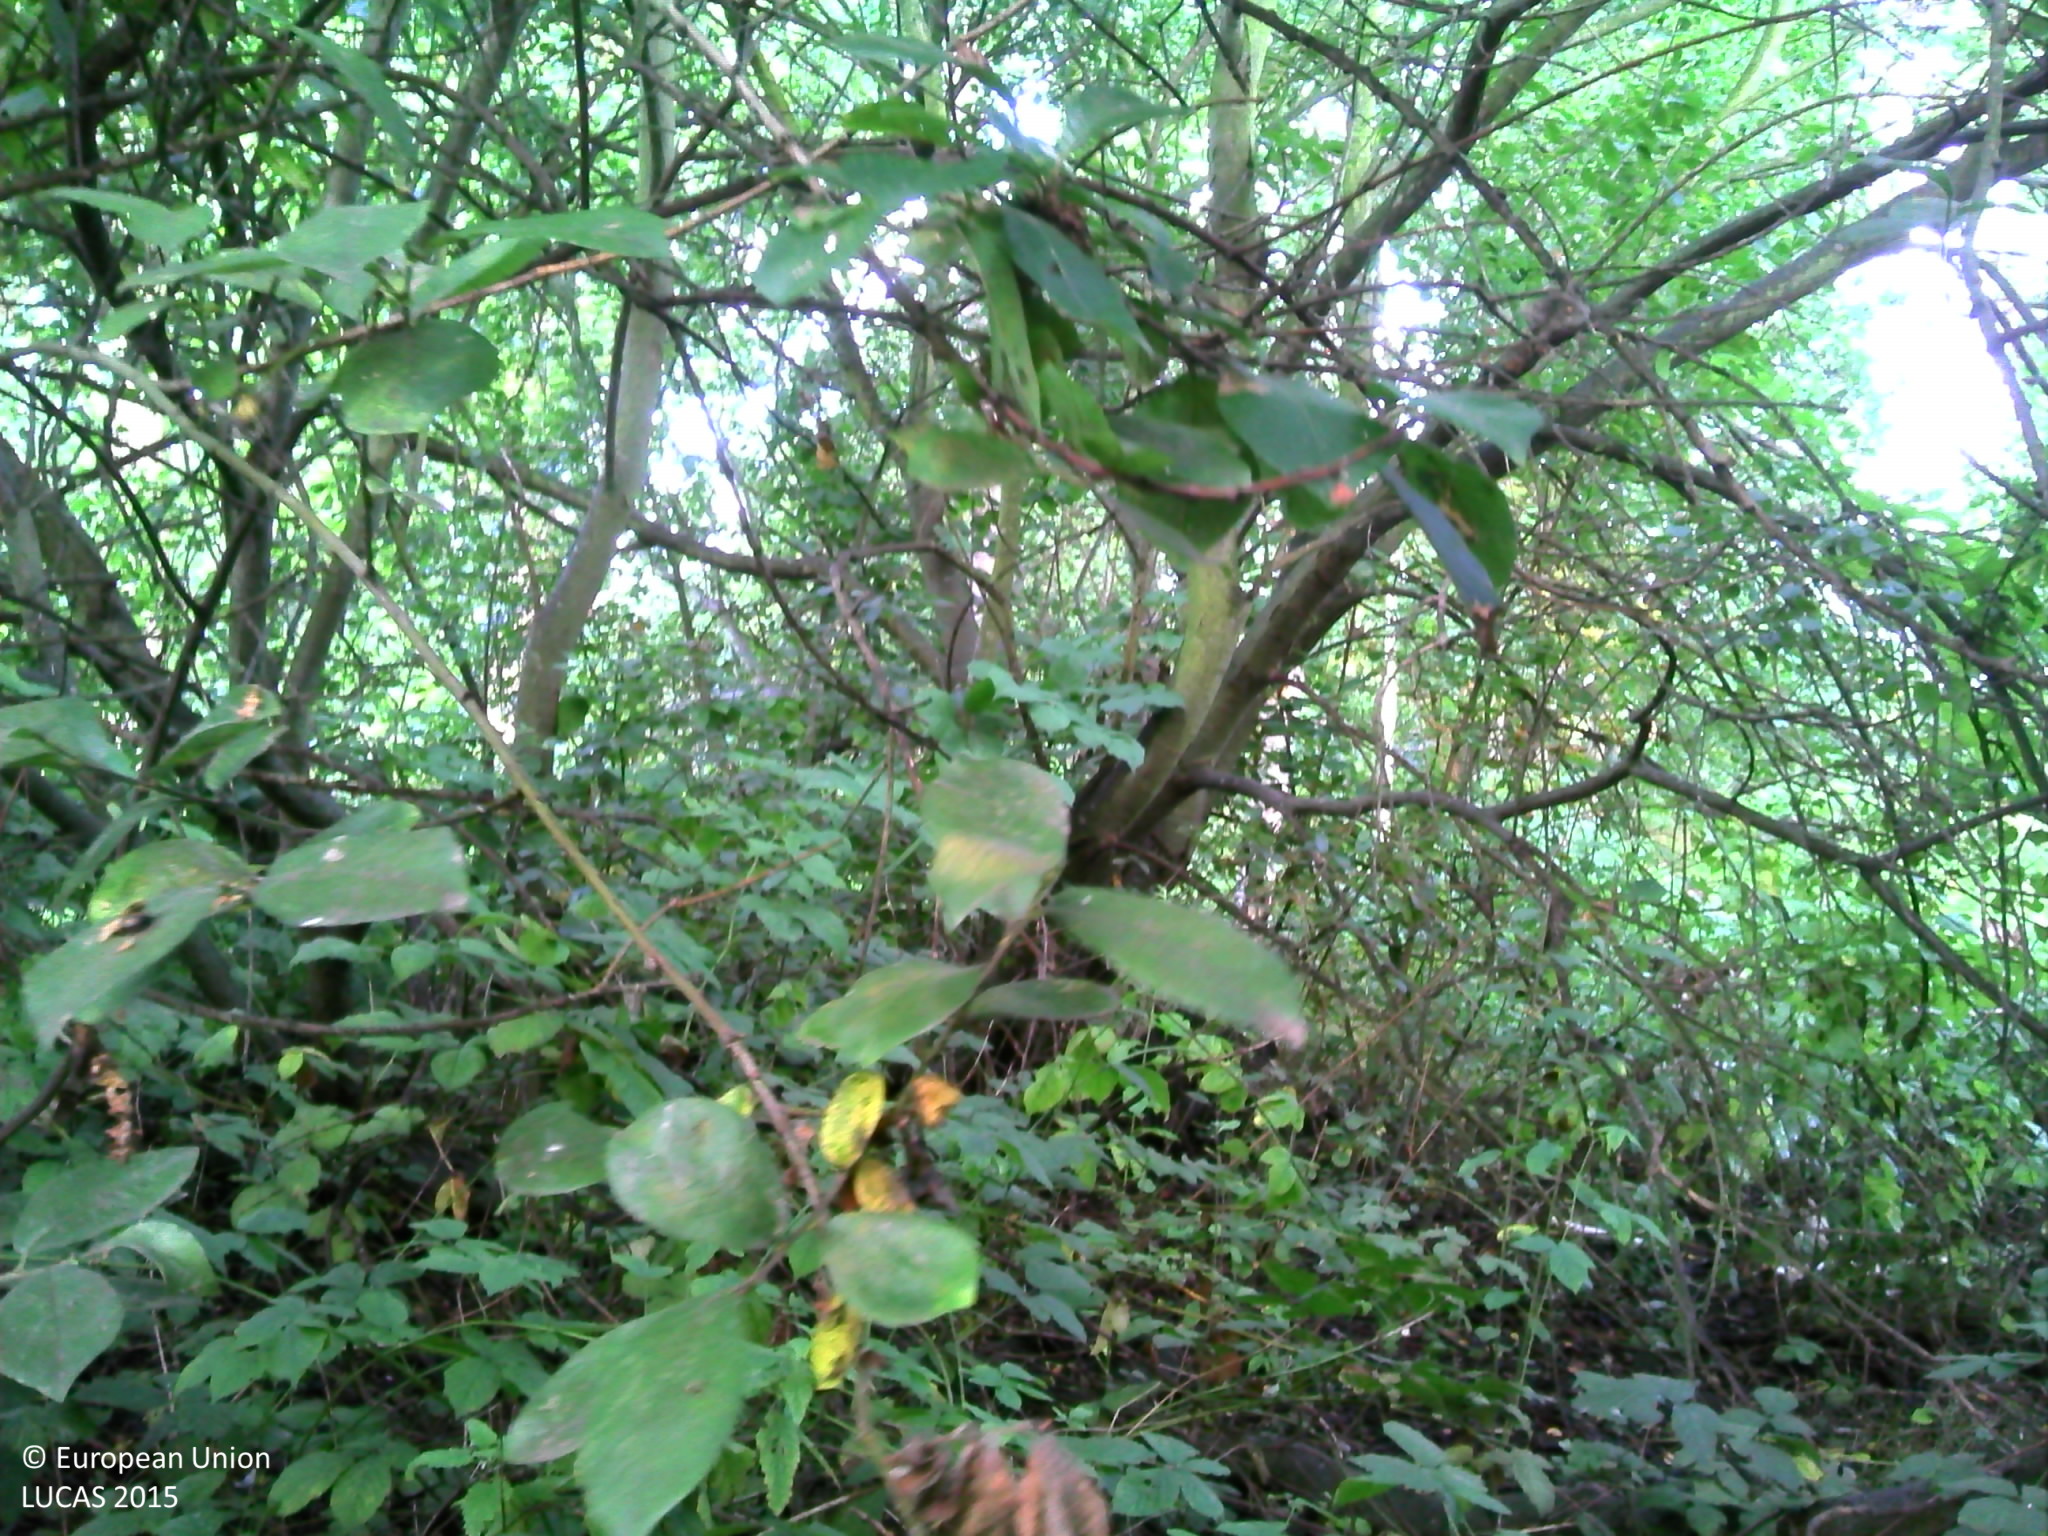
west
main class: Woodland
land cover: Broadleaved woodland
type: floodplain forest
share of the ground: > 75 %
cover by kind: broadleaved forest trees 70 %, herbaceous plants 20 %, shrubs 10 %
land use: Forestry
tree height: > 5 m
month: September
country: BE
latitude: 51.0720
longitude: 4.3579
